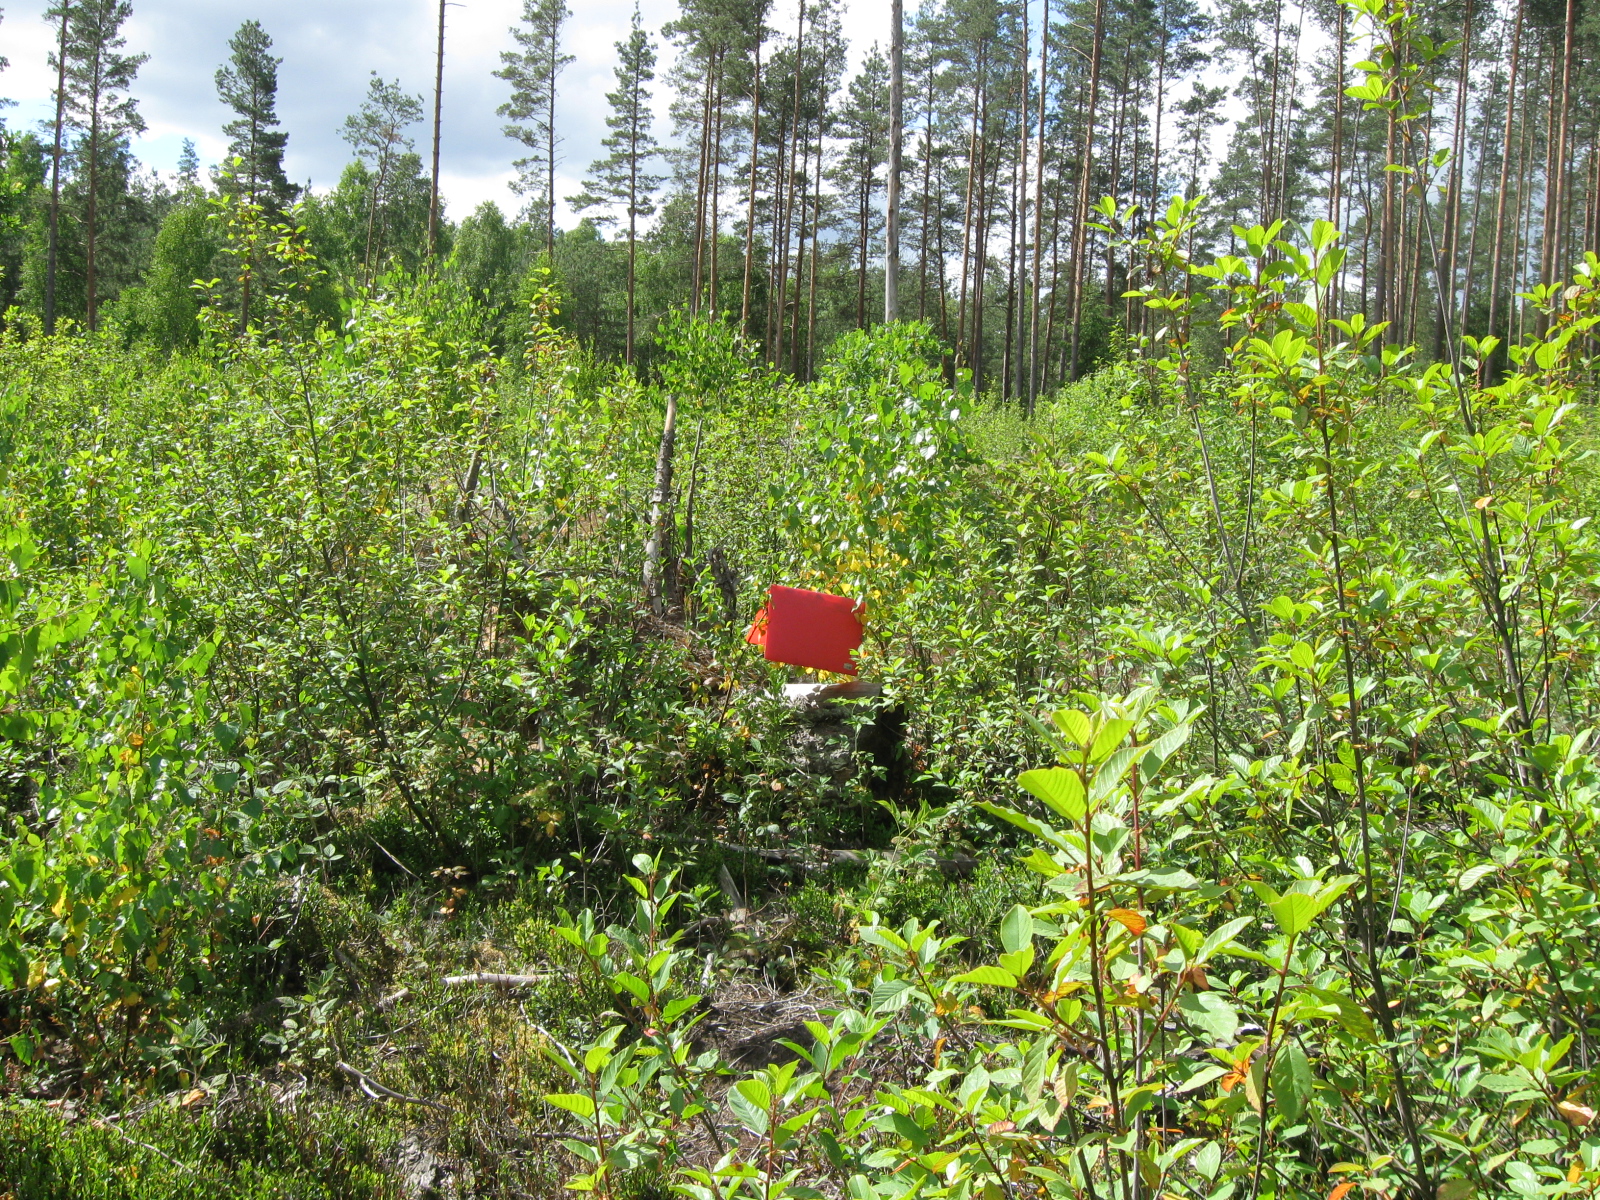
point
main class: Woodland
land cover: Broadleaved woodland
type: non-riverine alder, birch or aspen forest
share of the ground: 50 - 75 %
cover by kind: broadleaved forest trees 65 %, shrubs 15 %, herbaceous plants 15 %, unconsolidated bare surface 5 %
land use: Forestry
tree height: < 5 m
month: July
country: LT
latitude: 54.3281
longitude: 24.5433
